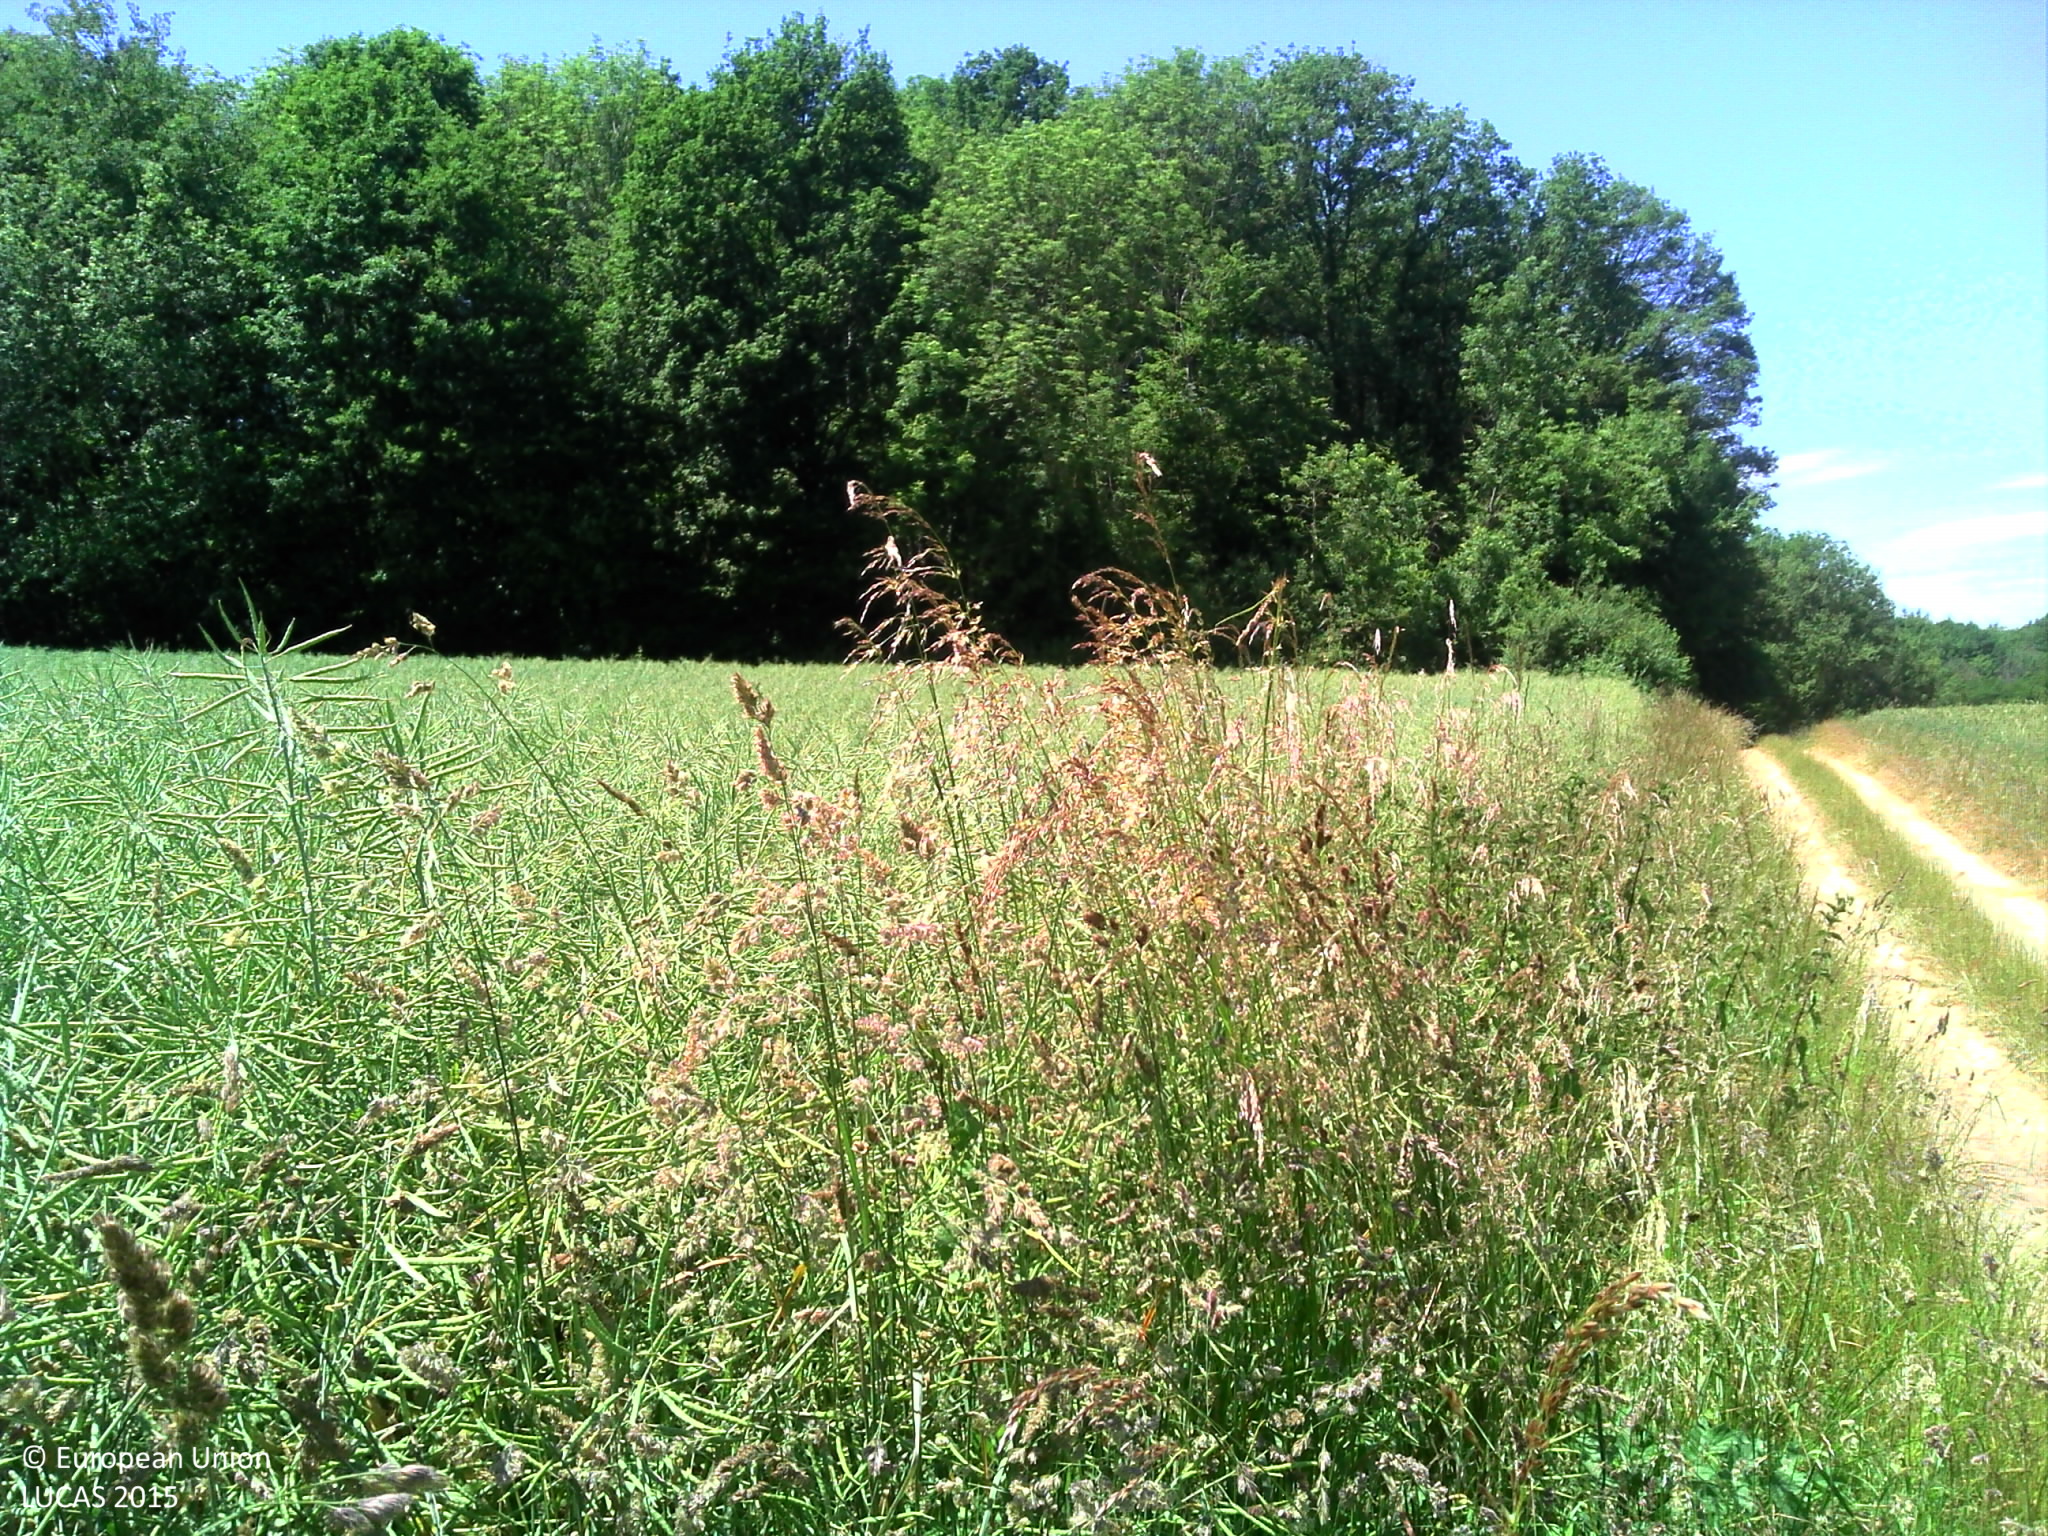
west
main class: Cropland
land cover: Rape and turnip rape
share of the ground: > 75 %
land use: Agriculture (excluding fallow land and kitchen gardens)
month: June
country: FR
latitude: 47.5394
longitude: 6.0290
